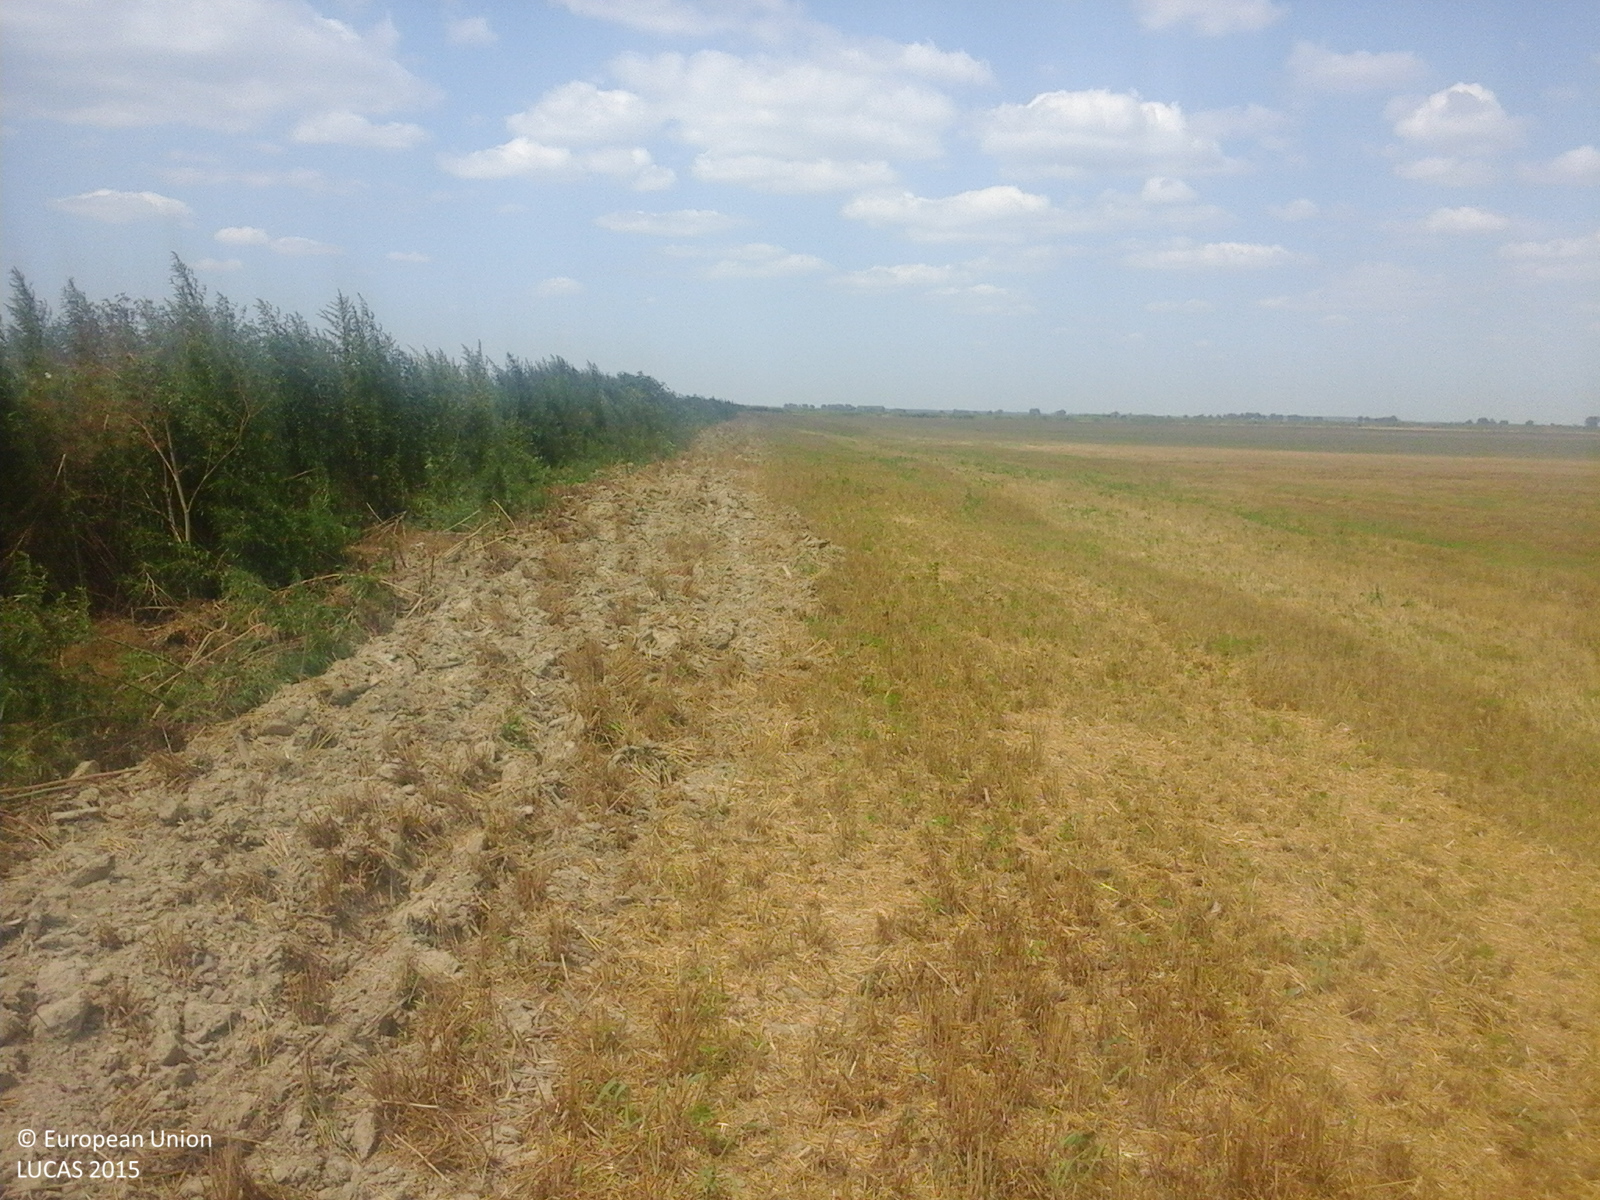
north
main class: Cropland
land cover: Barley
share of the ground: < 10 %
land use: Agriculture (excluding fallow land and kitchen gardens)
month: August
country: RO
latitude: 45.2907
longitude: 29.1130
